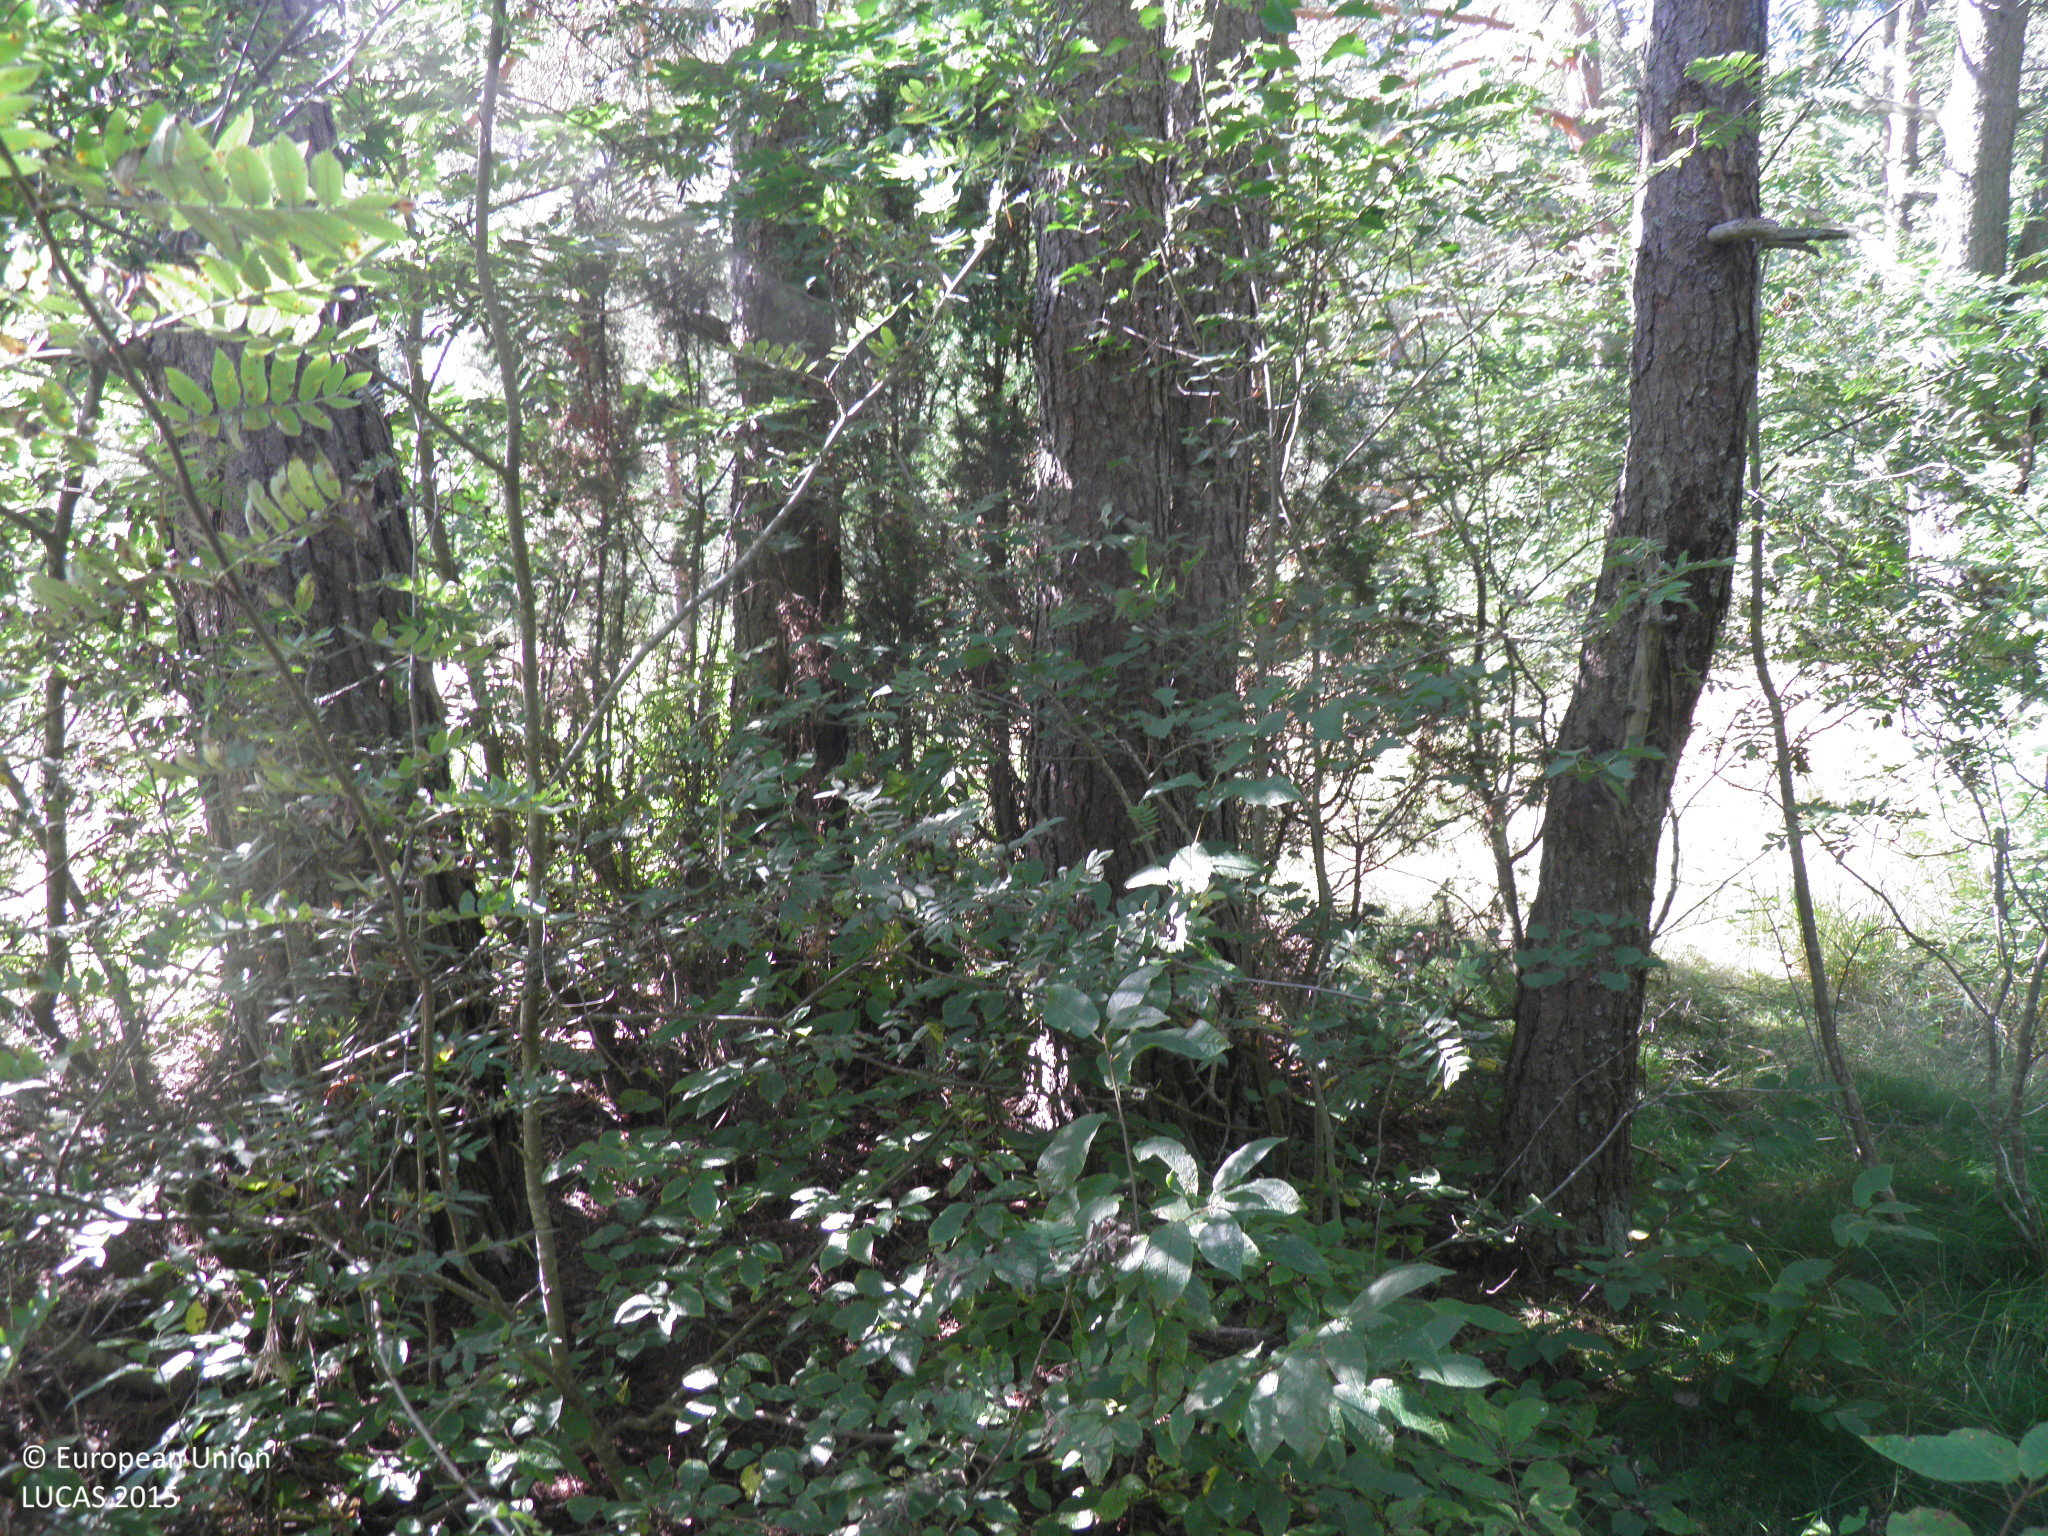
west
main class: Woodland
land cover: Pine dominated mixed woodland
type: hemiboreal forest and nemoral coniferous forest and mixed broadleaved-coniferous forest
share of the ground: > 75 %
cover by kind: coniferous forest trees 55 %, broadleaved forest trees 35 %, herbaceous plants 10 %
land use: Abandoned areas
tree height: > 5 m
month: August
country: FI
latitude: 60.8166
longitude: 21.5460
